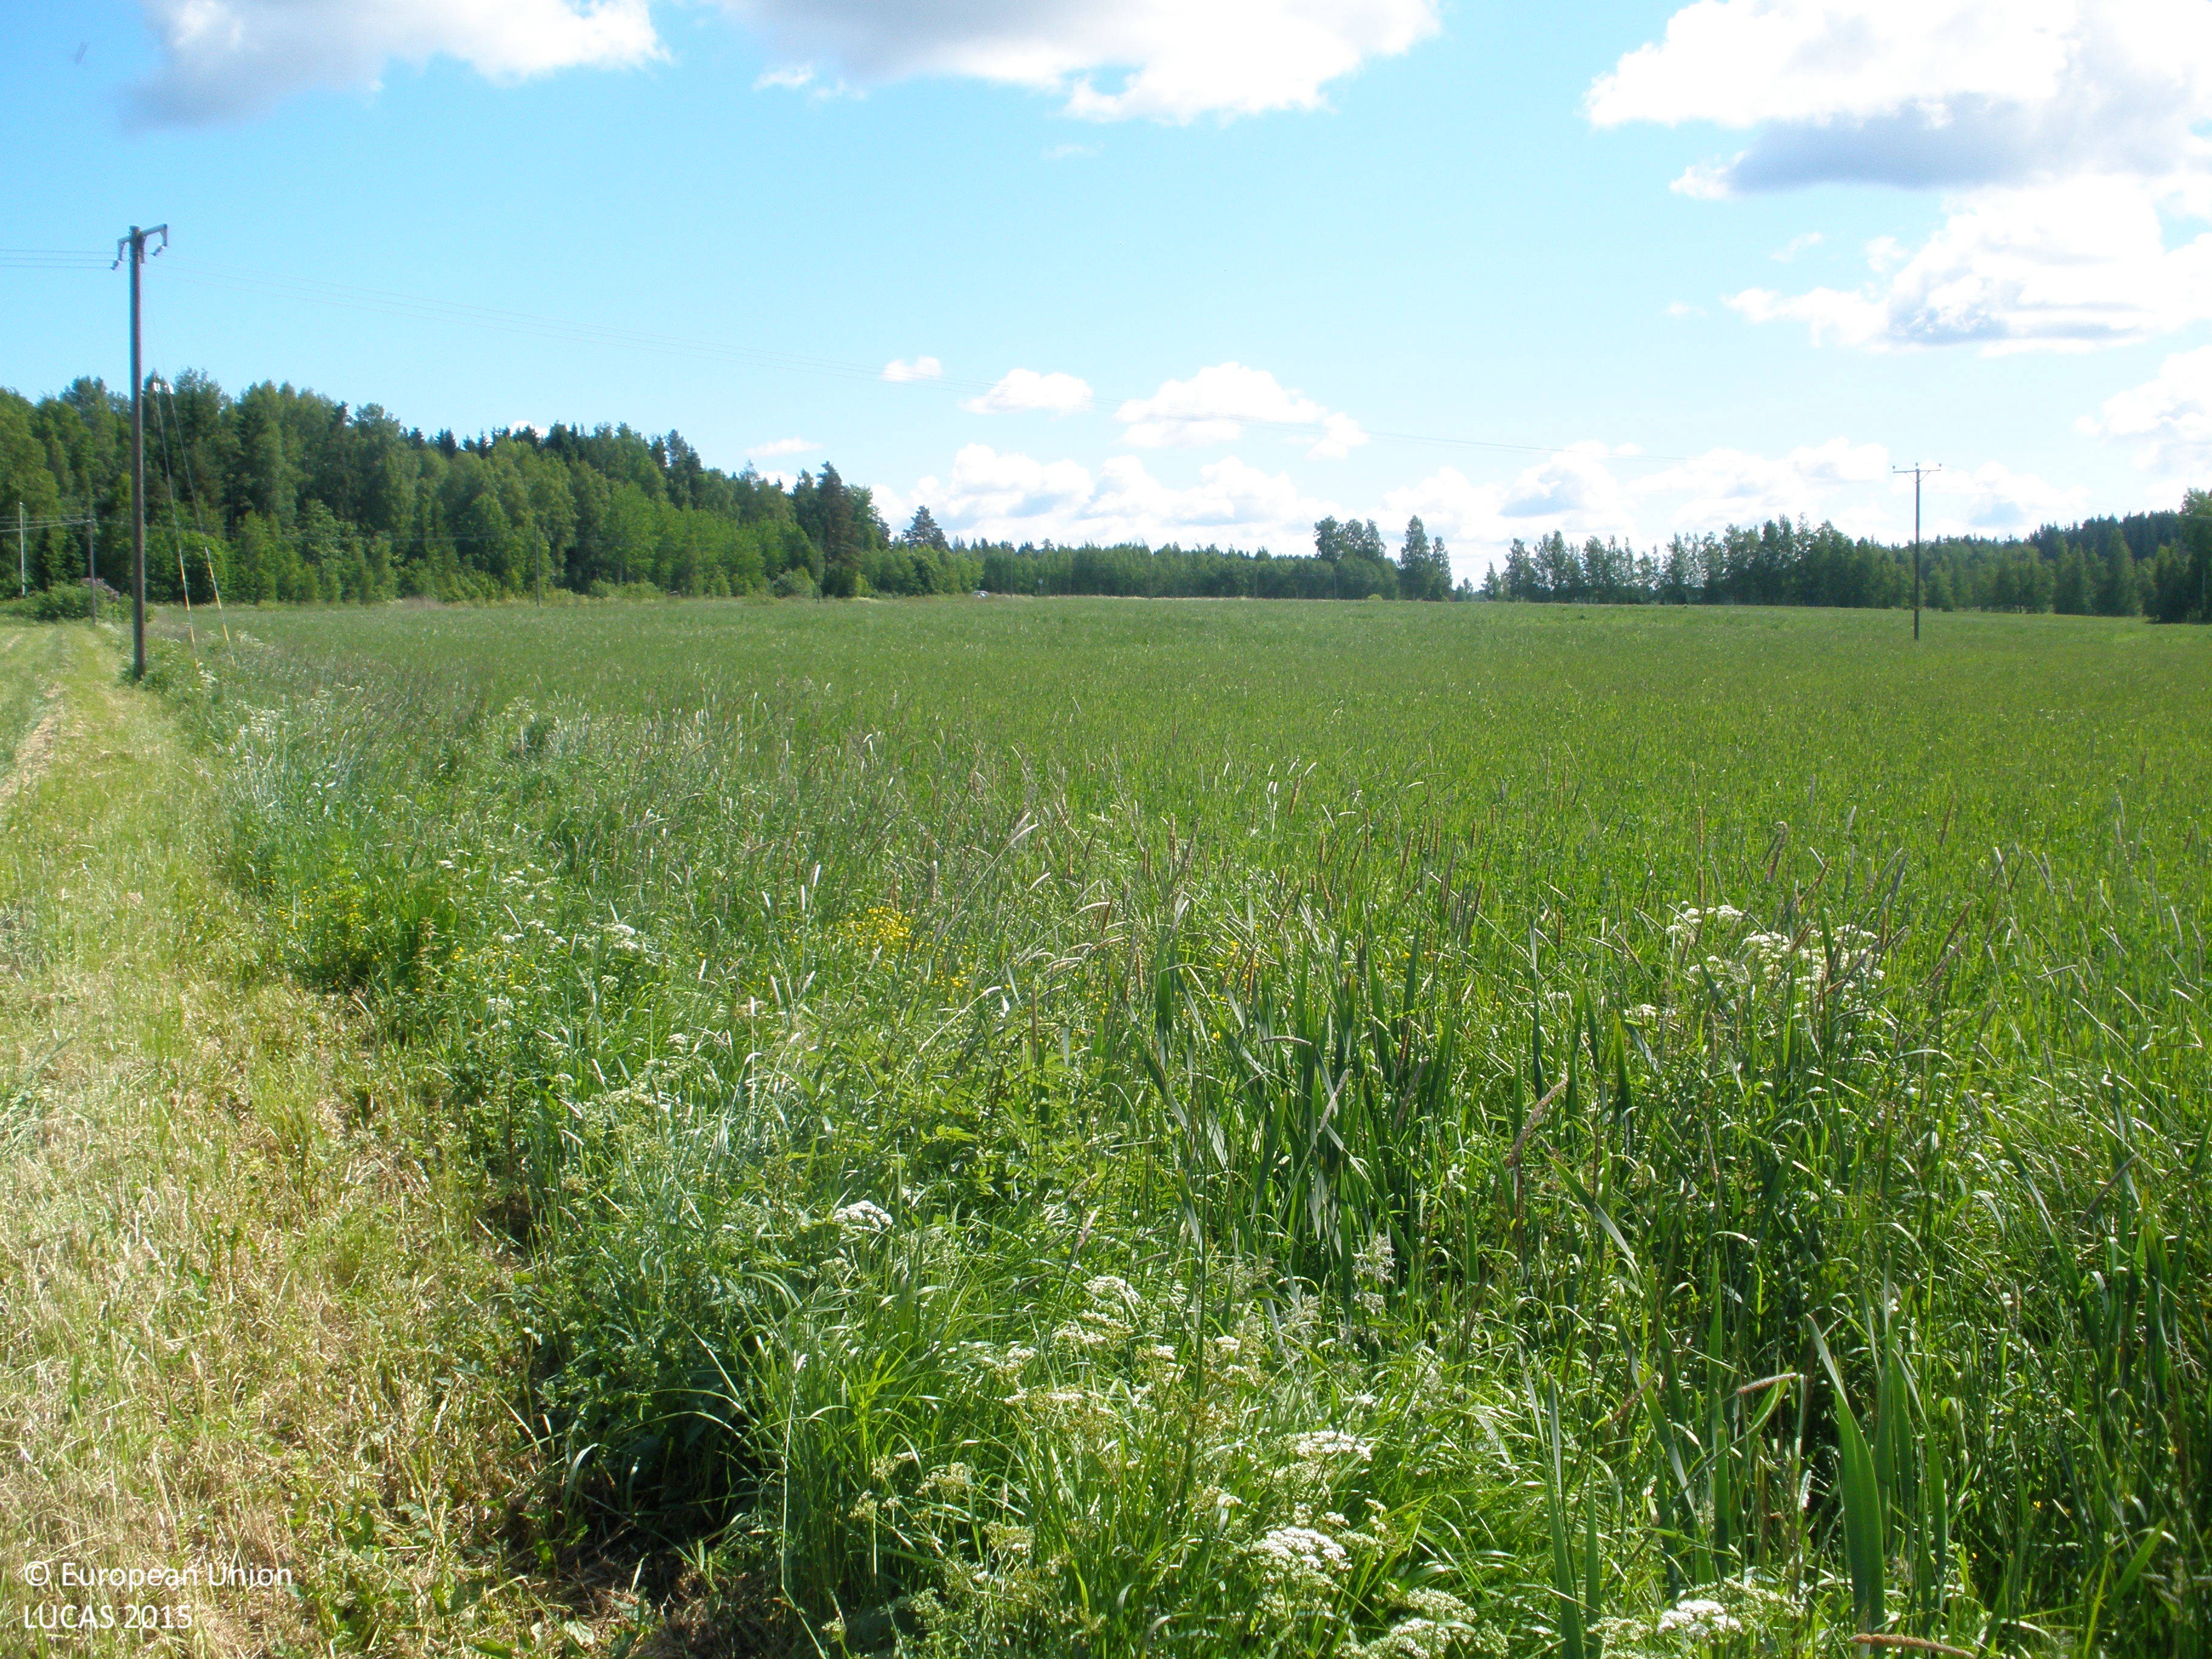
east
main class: Grassland
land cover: Grassland without tree/shrub cover
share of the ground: > 75 %
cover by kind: herbaceous plants 100 %
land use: Agriculture (excluding fallow land and kitchen gardens)
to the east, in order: Grassland without tree/shrub cover; Ditches and canals; Grassland without tree/shrub cover; Mixed cereals for fodder; Electric lines; Mixed cereals for fodder
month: June
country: FI
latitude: 61.0751
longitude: 24.1628
